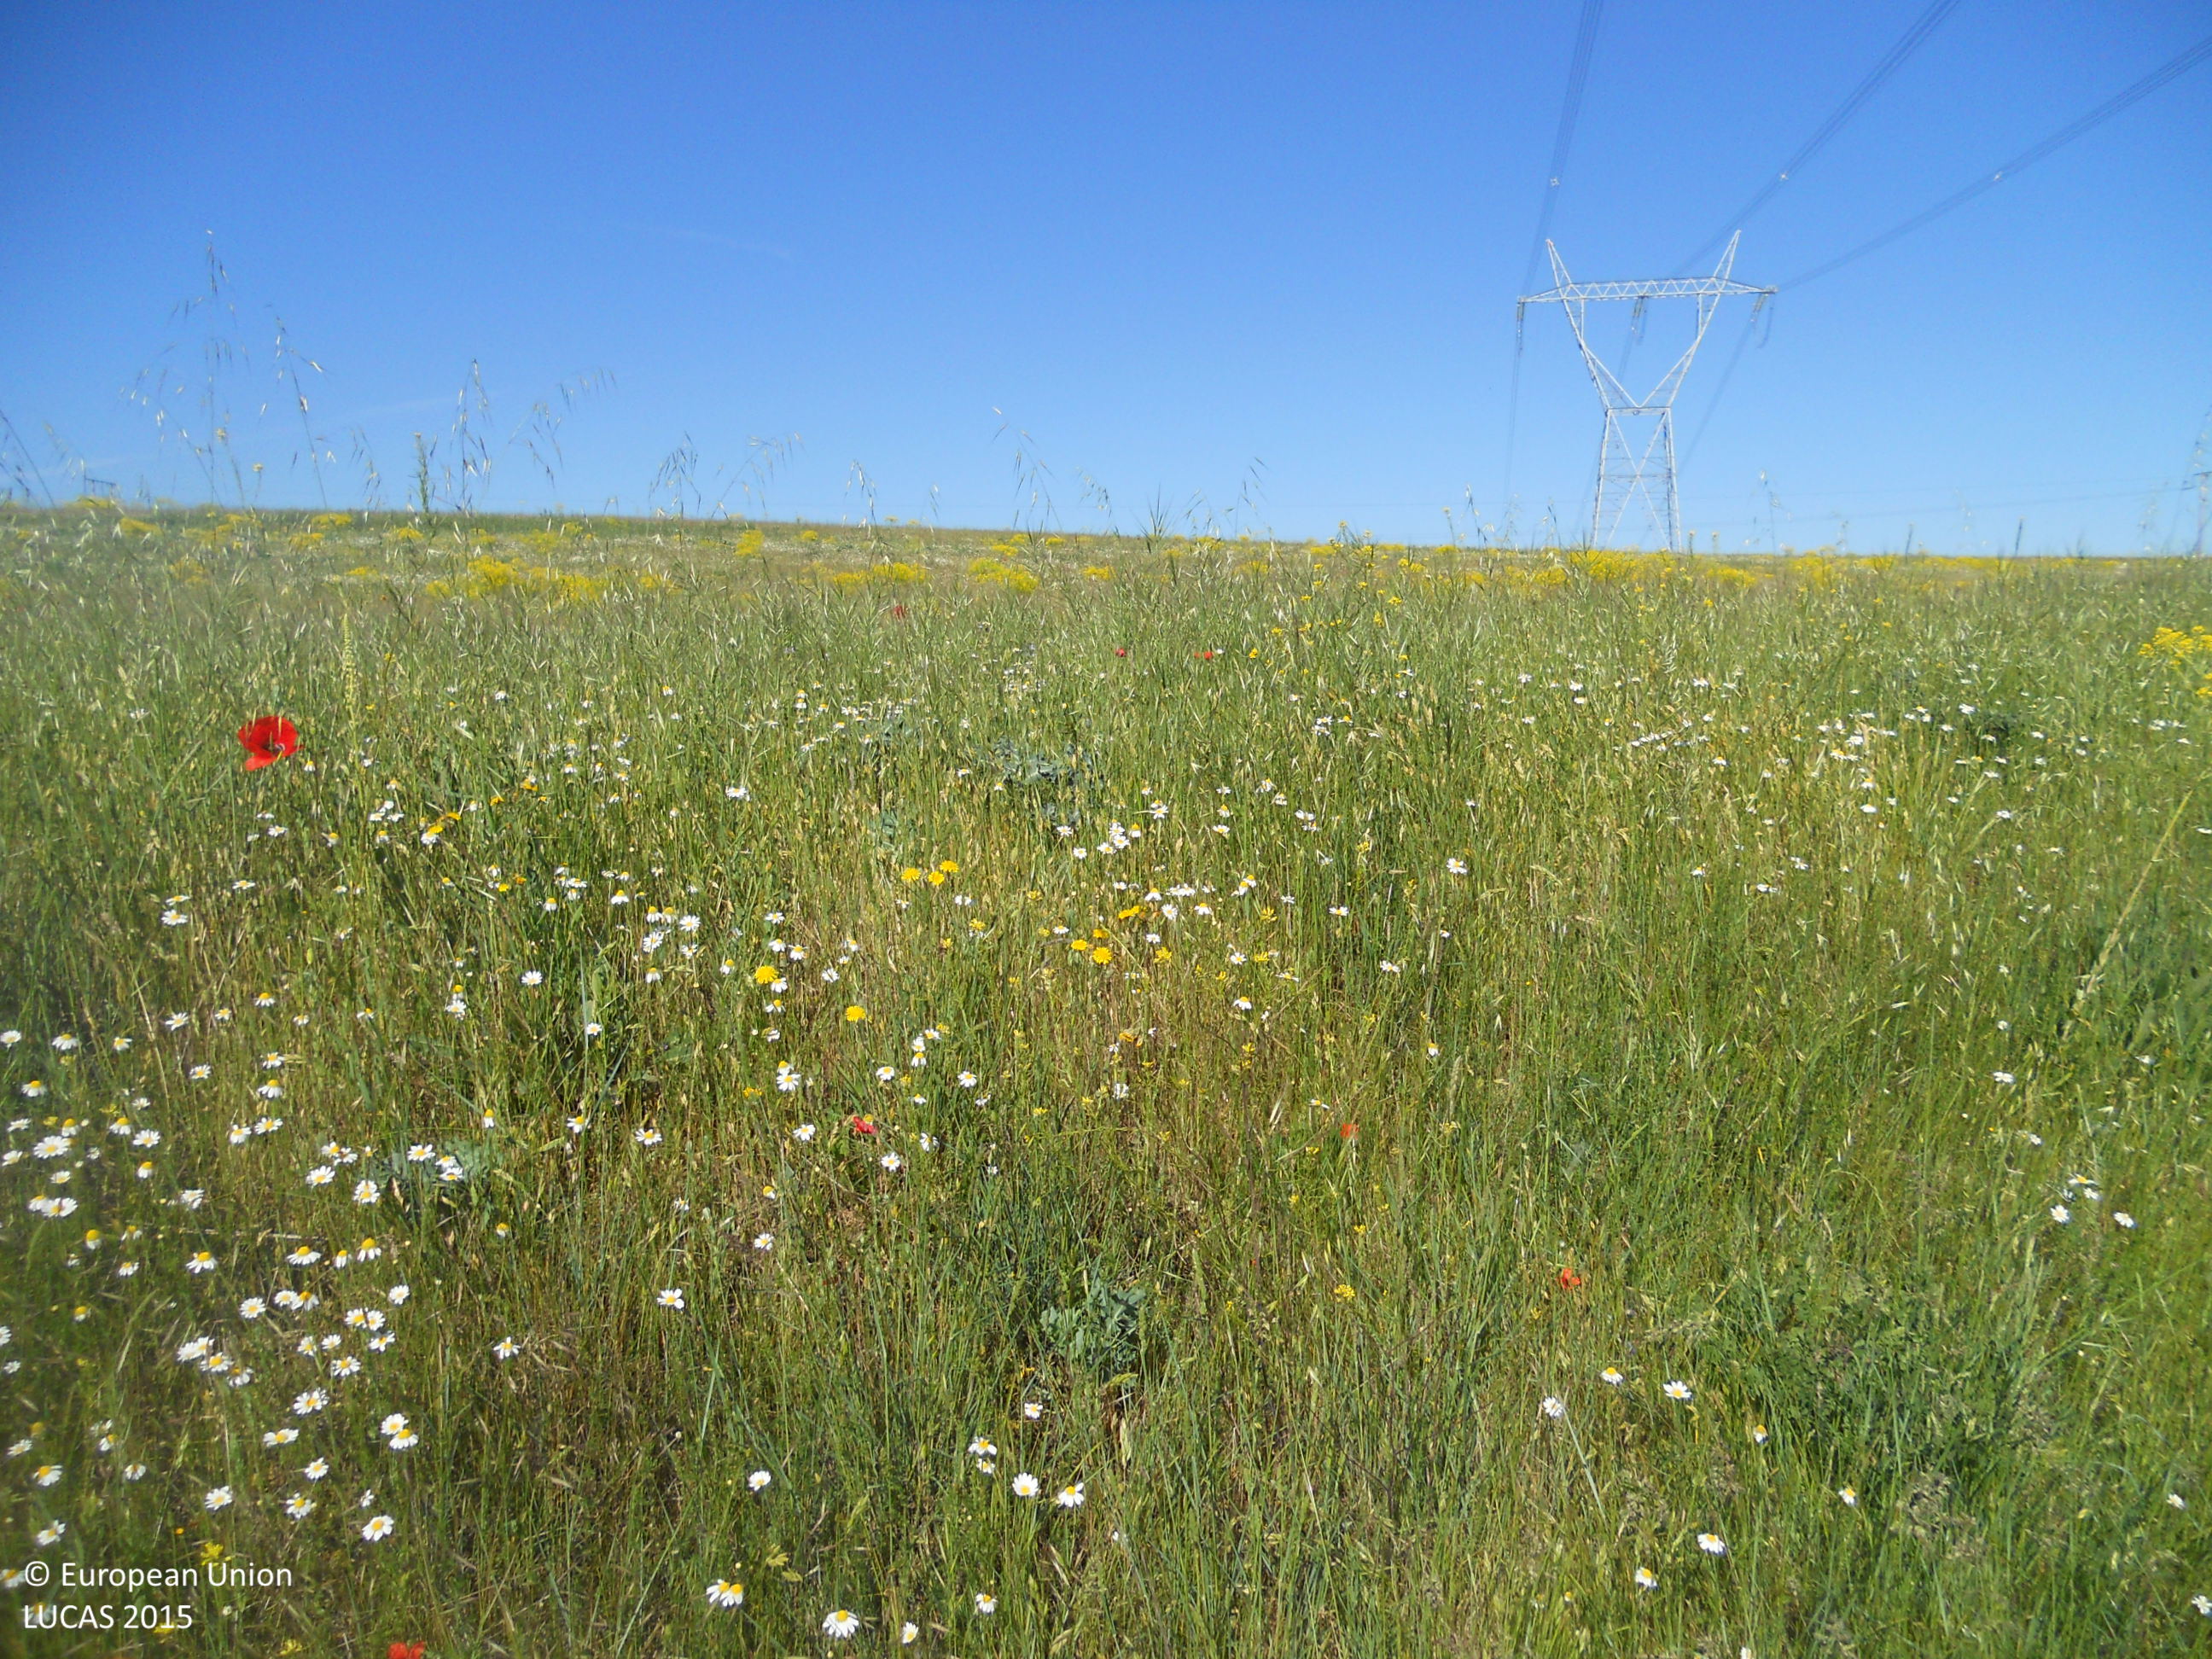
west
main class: Grassland
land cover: Grassland without tree/shrub cover
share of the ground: > 75 %
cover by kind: herbaceous plants 100 %
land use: Semi-natural and natural areas not in use
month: May
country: ES
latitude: 42.4504
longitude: -5.5737
